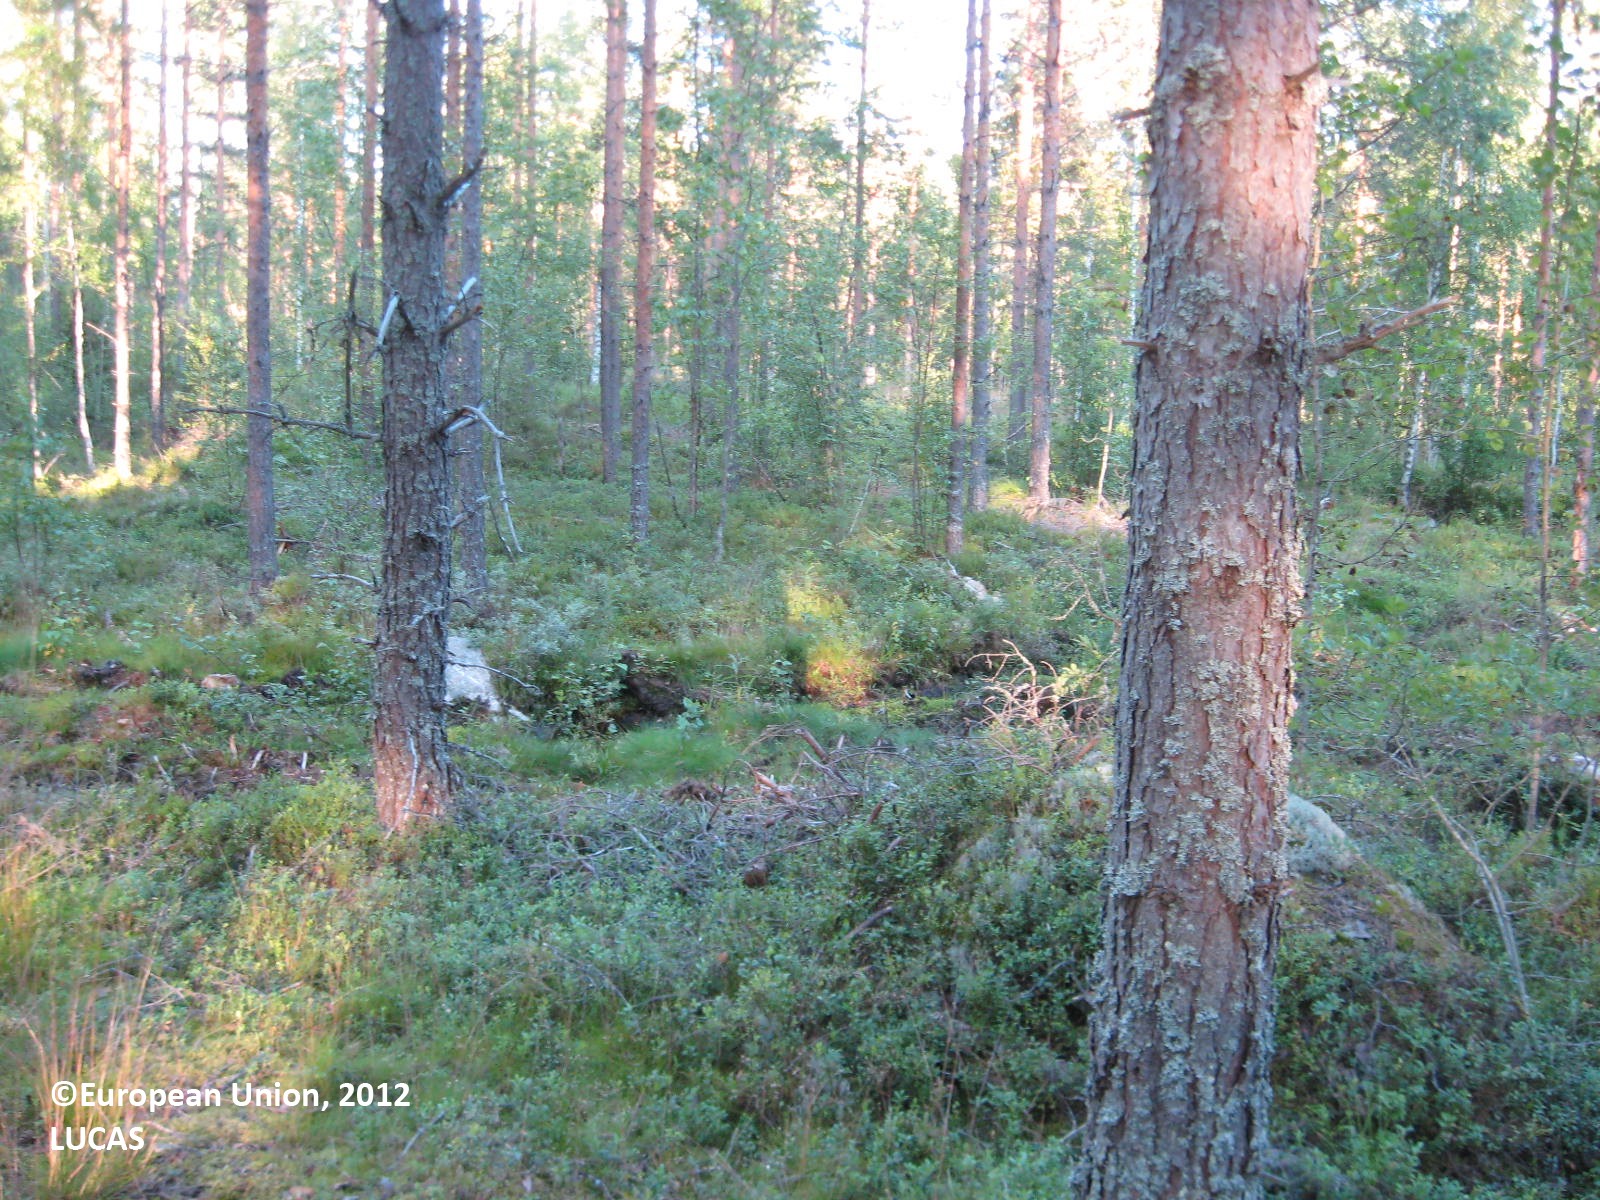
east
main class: Woodland
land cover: Pine dominated coniferous woodland
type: boreal forest
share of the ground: > 75 %
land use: Forestry
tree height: > 5 m
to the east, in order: Pine dominated coniferous woodland; Ditches and canals; Grass margins; Paved roads, cycling and walking lanes; Broadleaved woodland; Ditches and canals; Pine dominated coniferous woodland
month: July
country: FI
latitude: 61.9435
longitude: 22.2735
